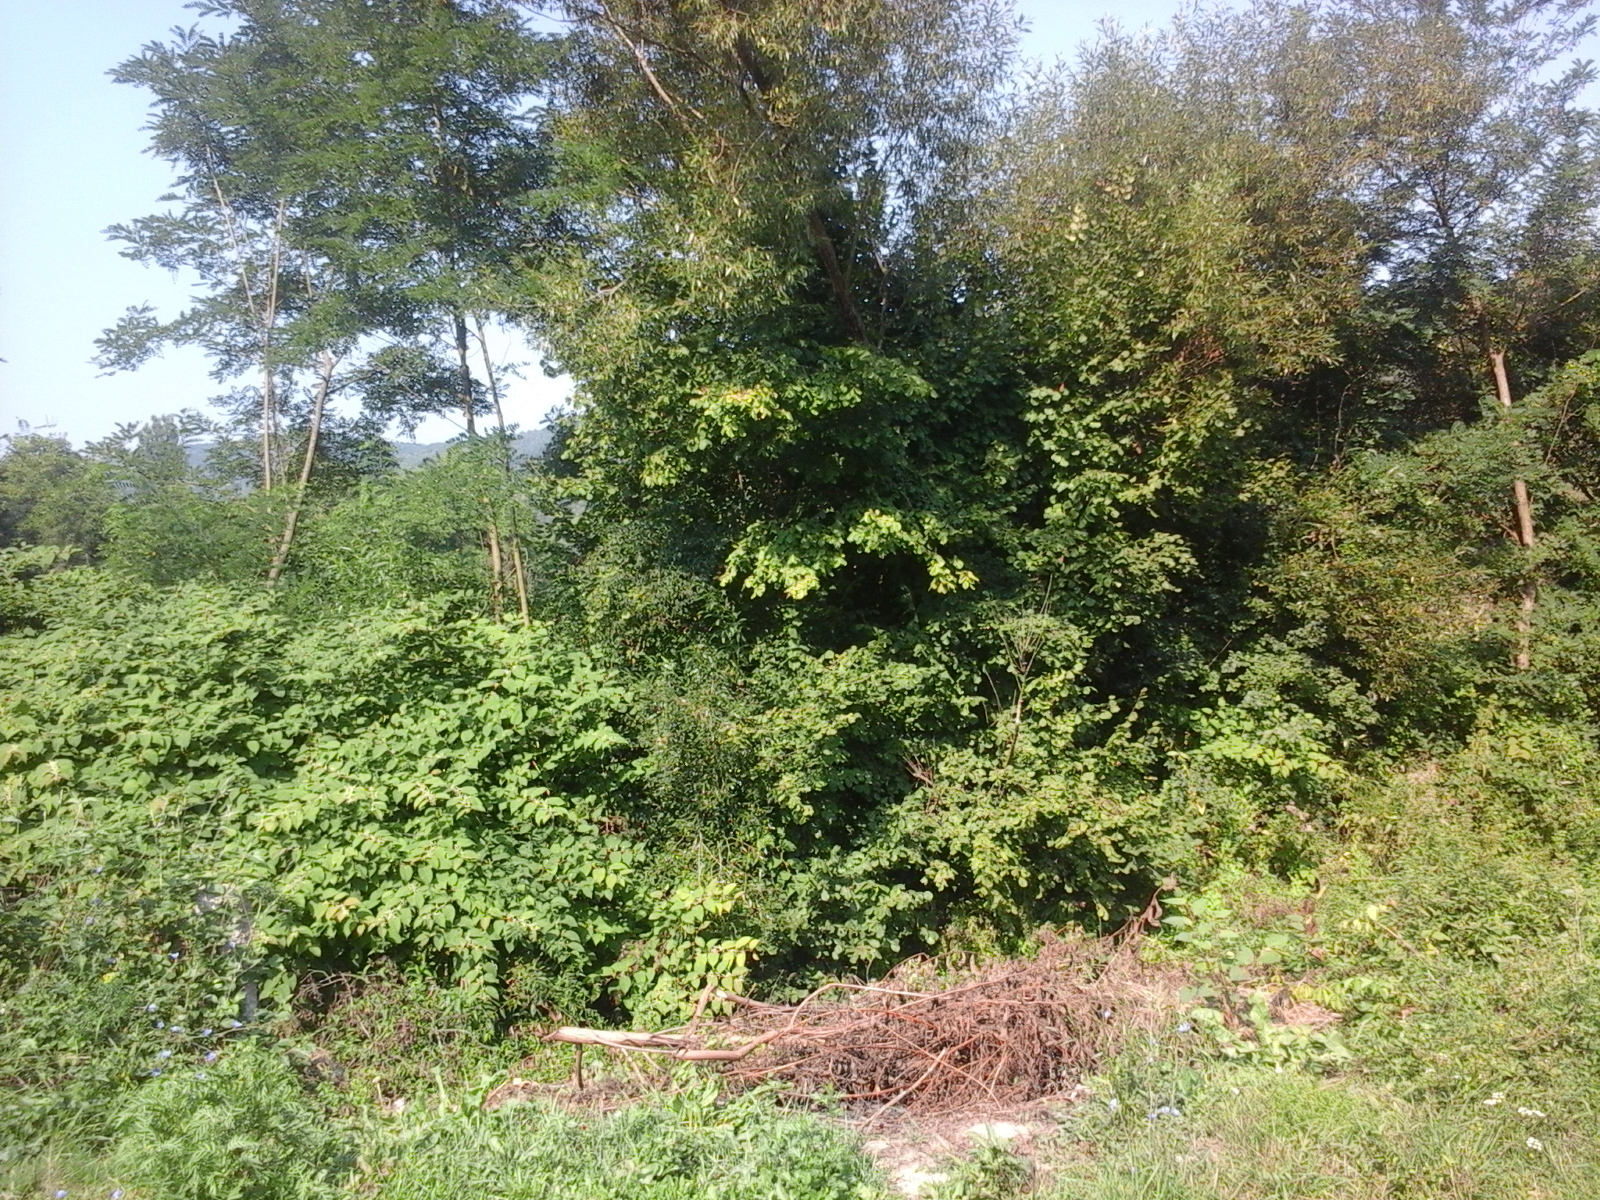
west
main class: Cropland
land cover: Maize
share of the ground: > 75 %
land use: Agriculture (excluding fallow land and kitchen gardens)
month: August
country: RO
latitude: 46.1704
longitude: 22.5755
